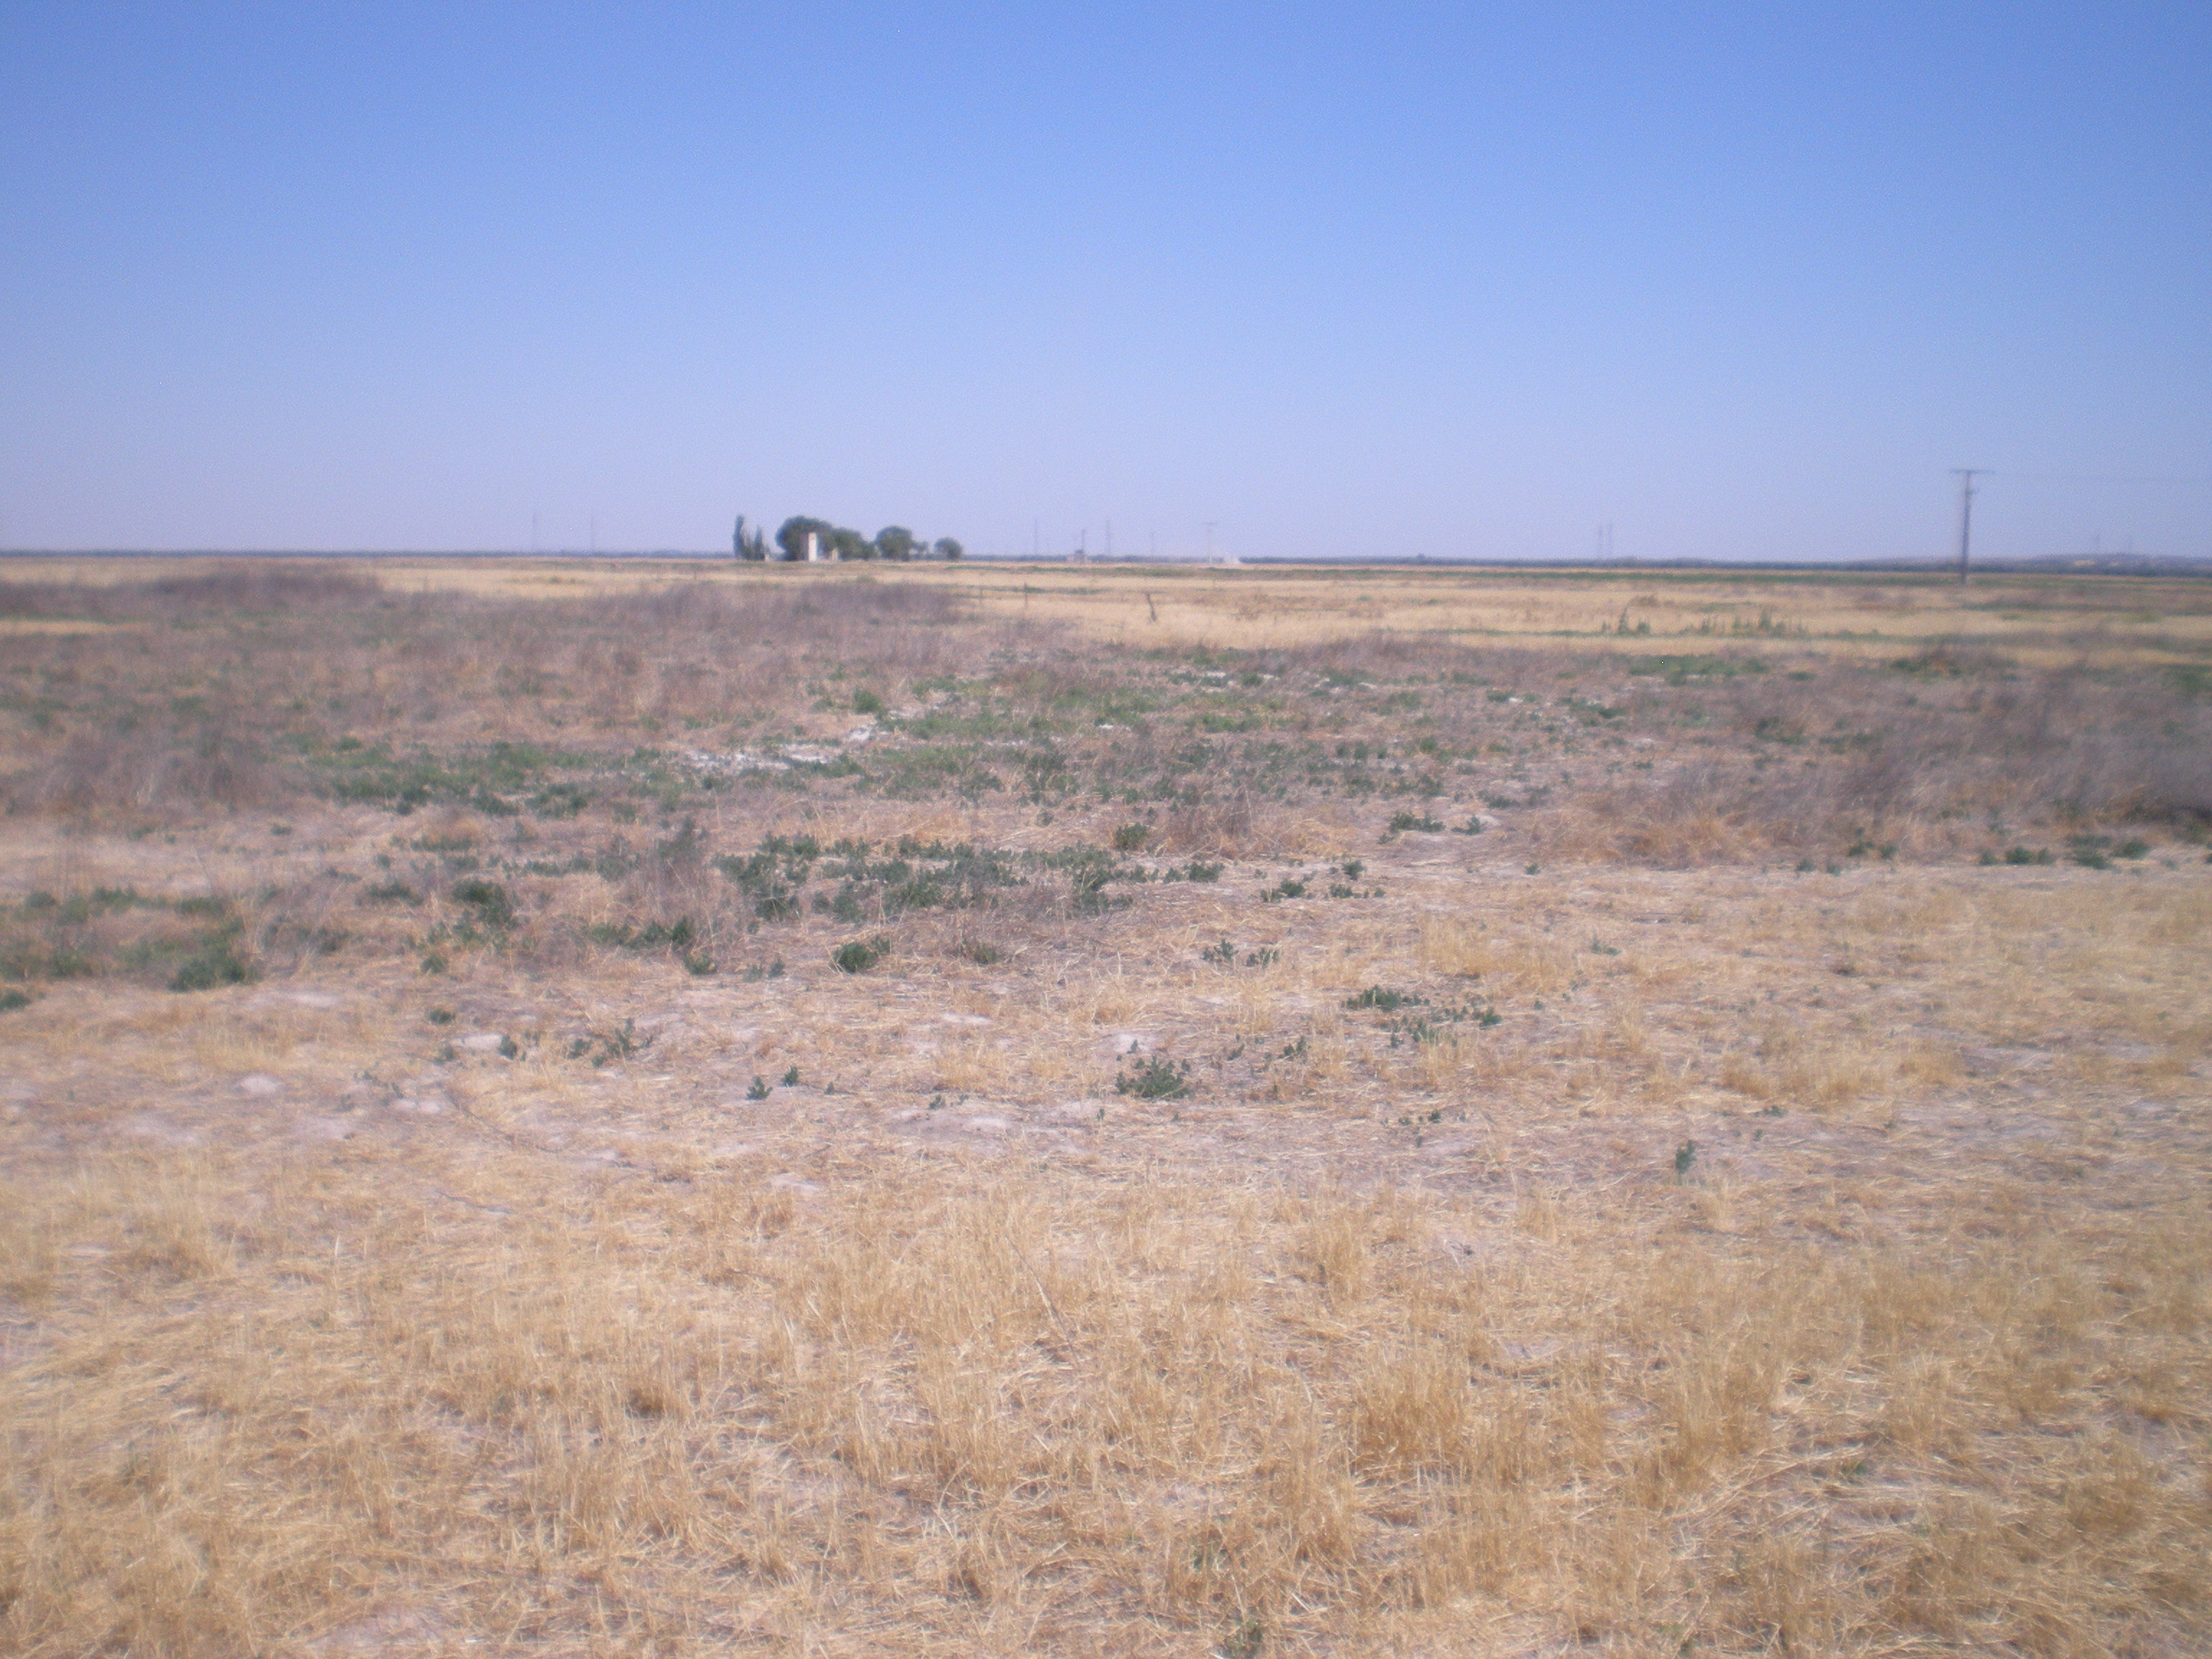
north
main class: Grassland
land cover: Grassland without tree/shrub cover
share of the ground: 10 - 25 %
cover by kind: unconsolidated bare surface 85 %, herbaceous plants 15 %
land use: Agriculture (excluding fallow land and kitchen gardens)
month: July
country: ES
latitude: 39.3387
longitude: -3.3027
